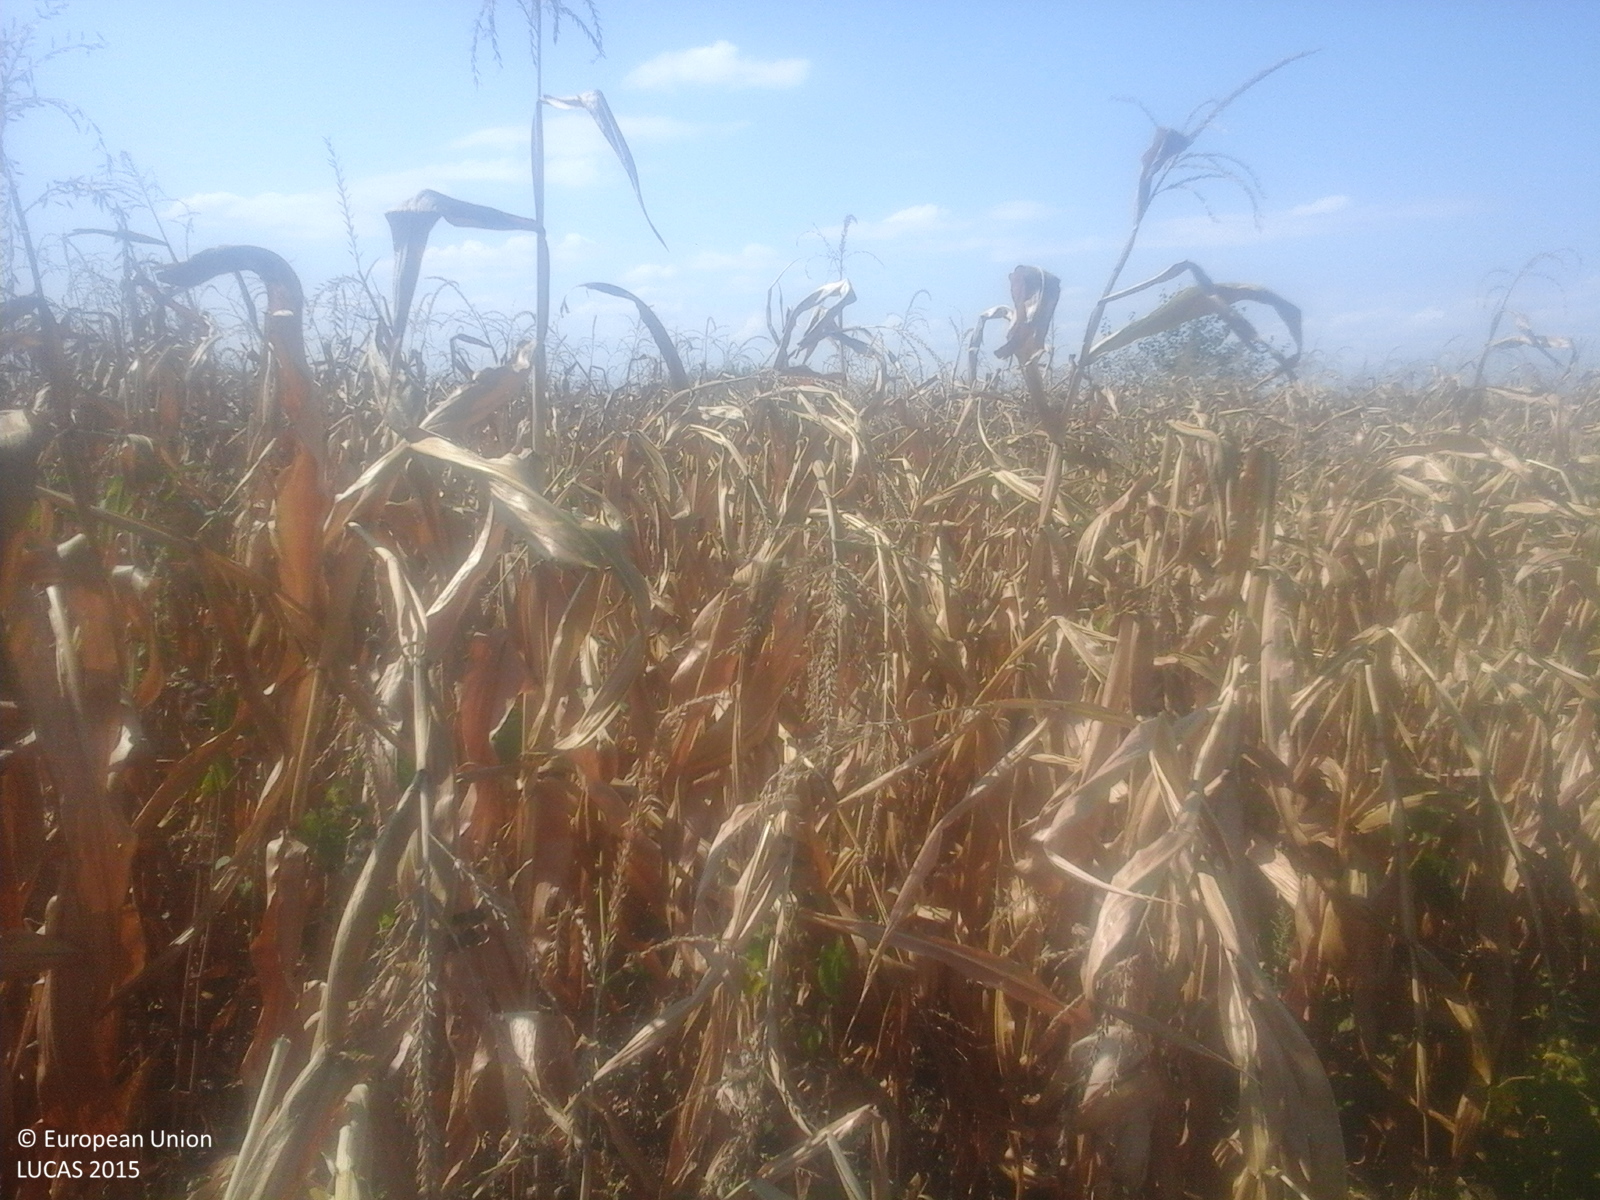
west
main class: Cropland
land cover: Maize
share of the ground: > 75 %
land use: Agriculture (excluding fallow land and kitchen gardens)
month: September
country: RO
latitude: 47.7330
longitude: 22.6073
